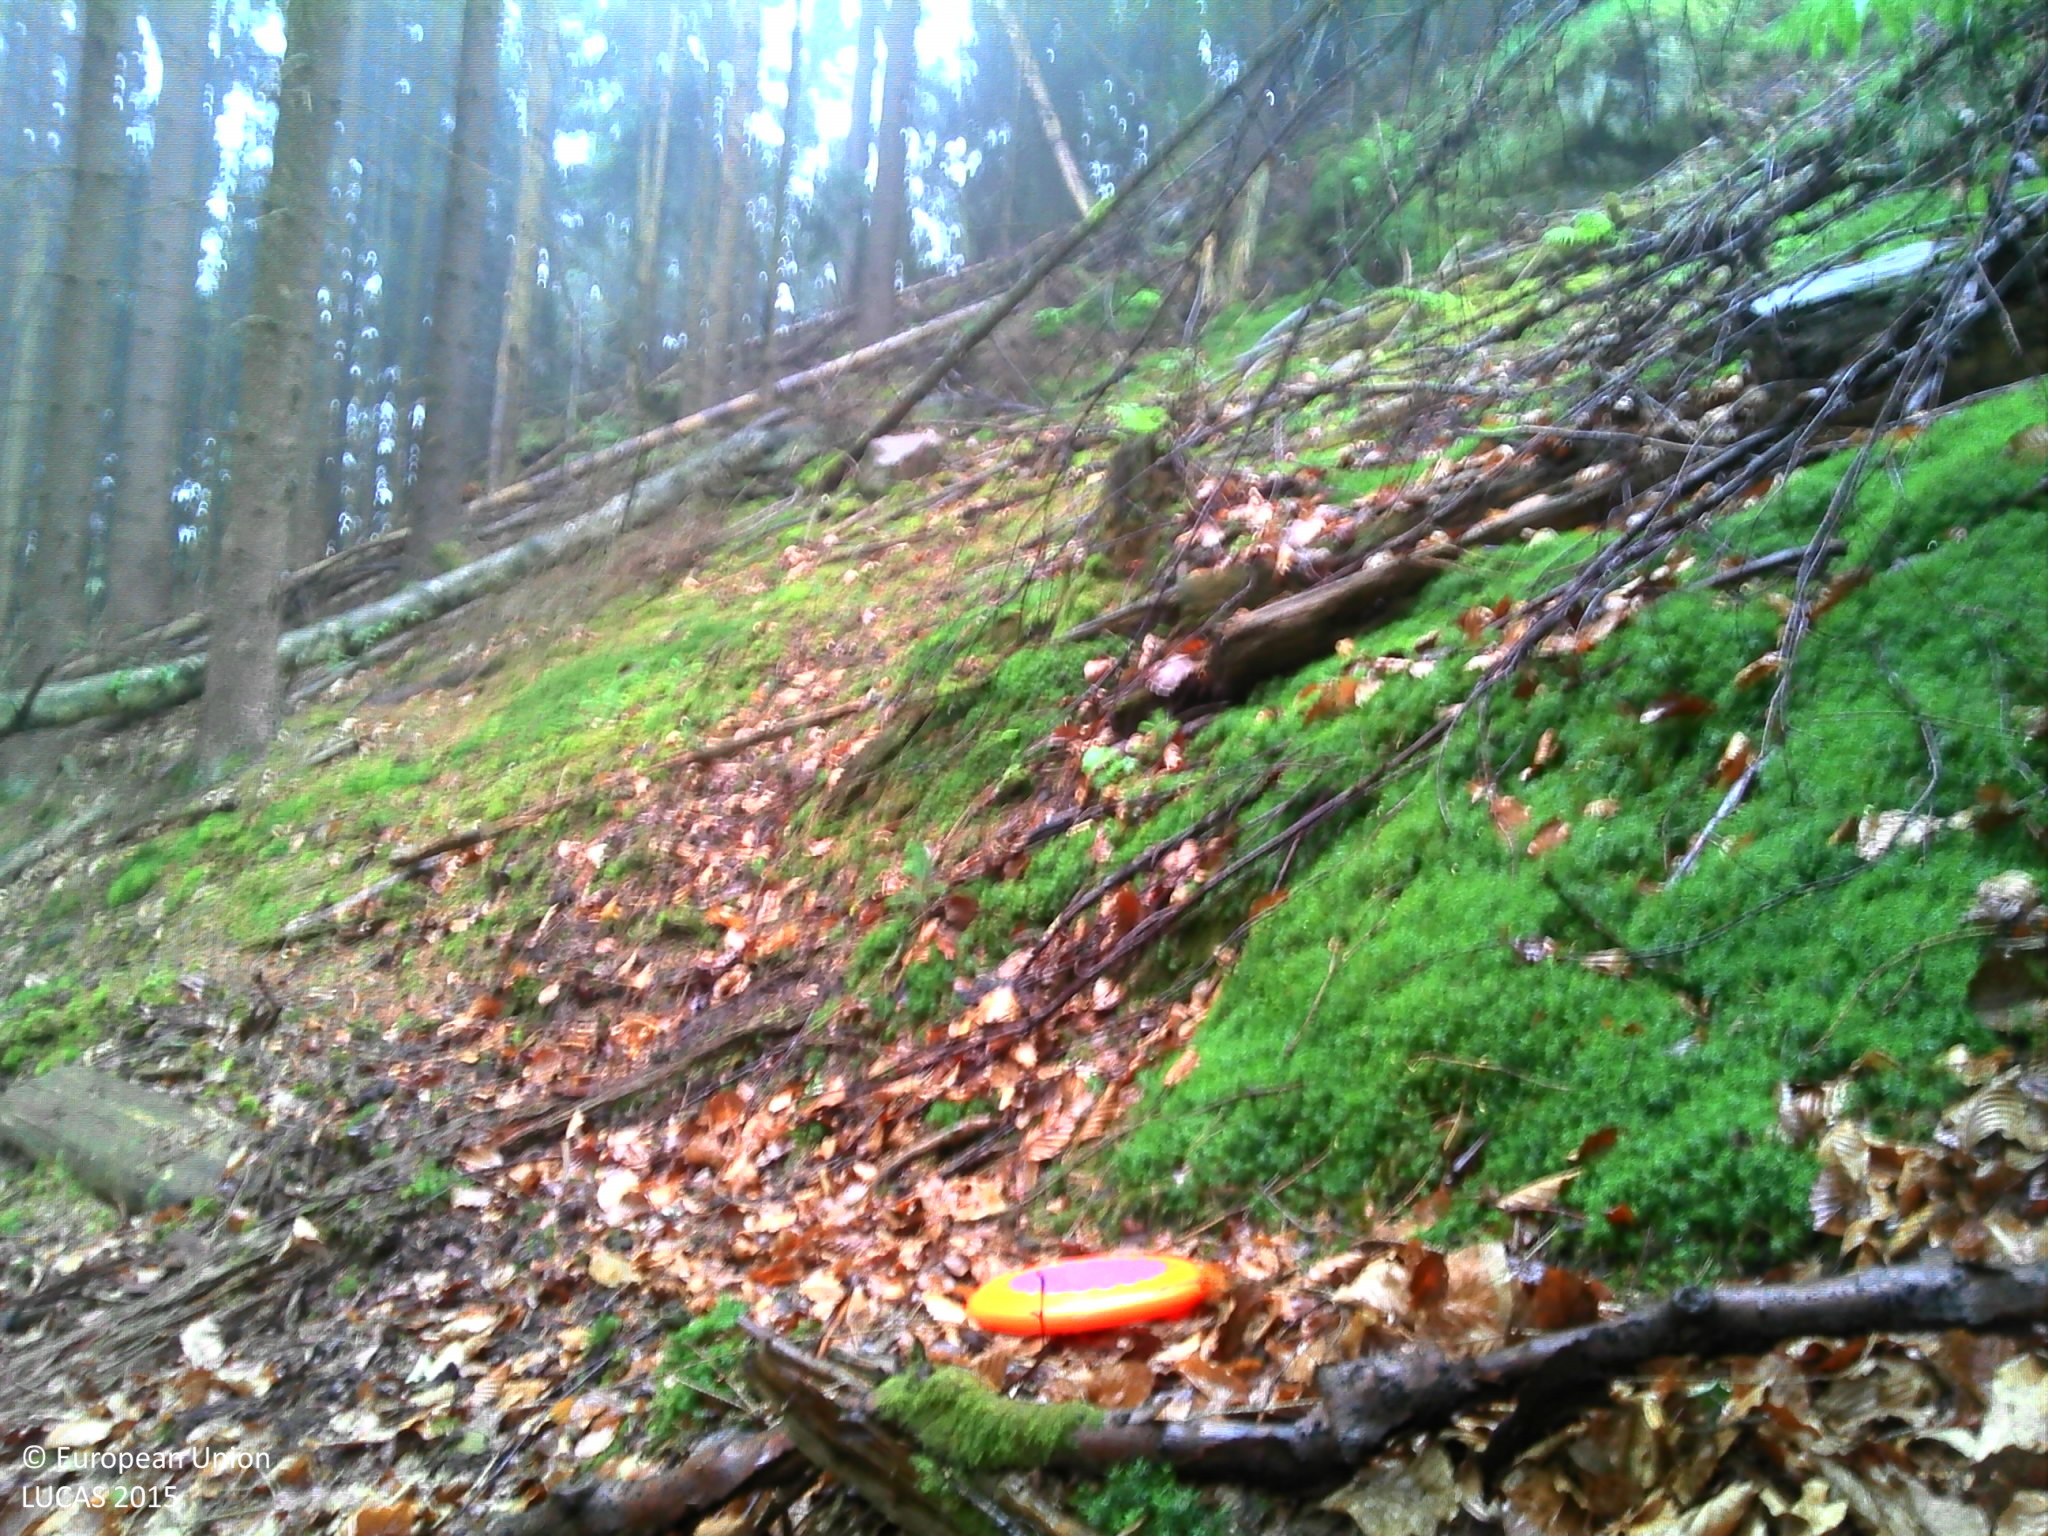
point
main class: Woodland
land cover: Spruce dominated mixed woodland
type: beech forest
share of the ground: > 75 %
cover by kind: coniferous forest trees 65 %, broadleaved forest trees 25 %, shrubs 5 %, herbaceous plants 5 %
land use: Forestry
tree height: > 5 m
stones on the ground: < 10 %
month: June
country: FR
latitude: 48.9919
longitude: 7.7183
